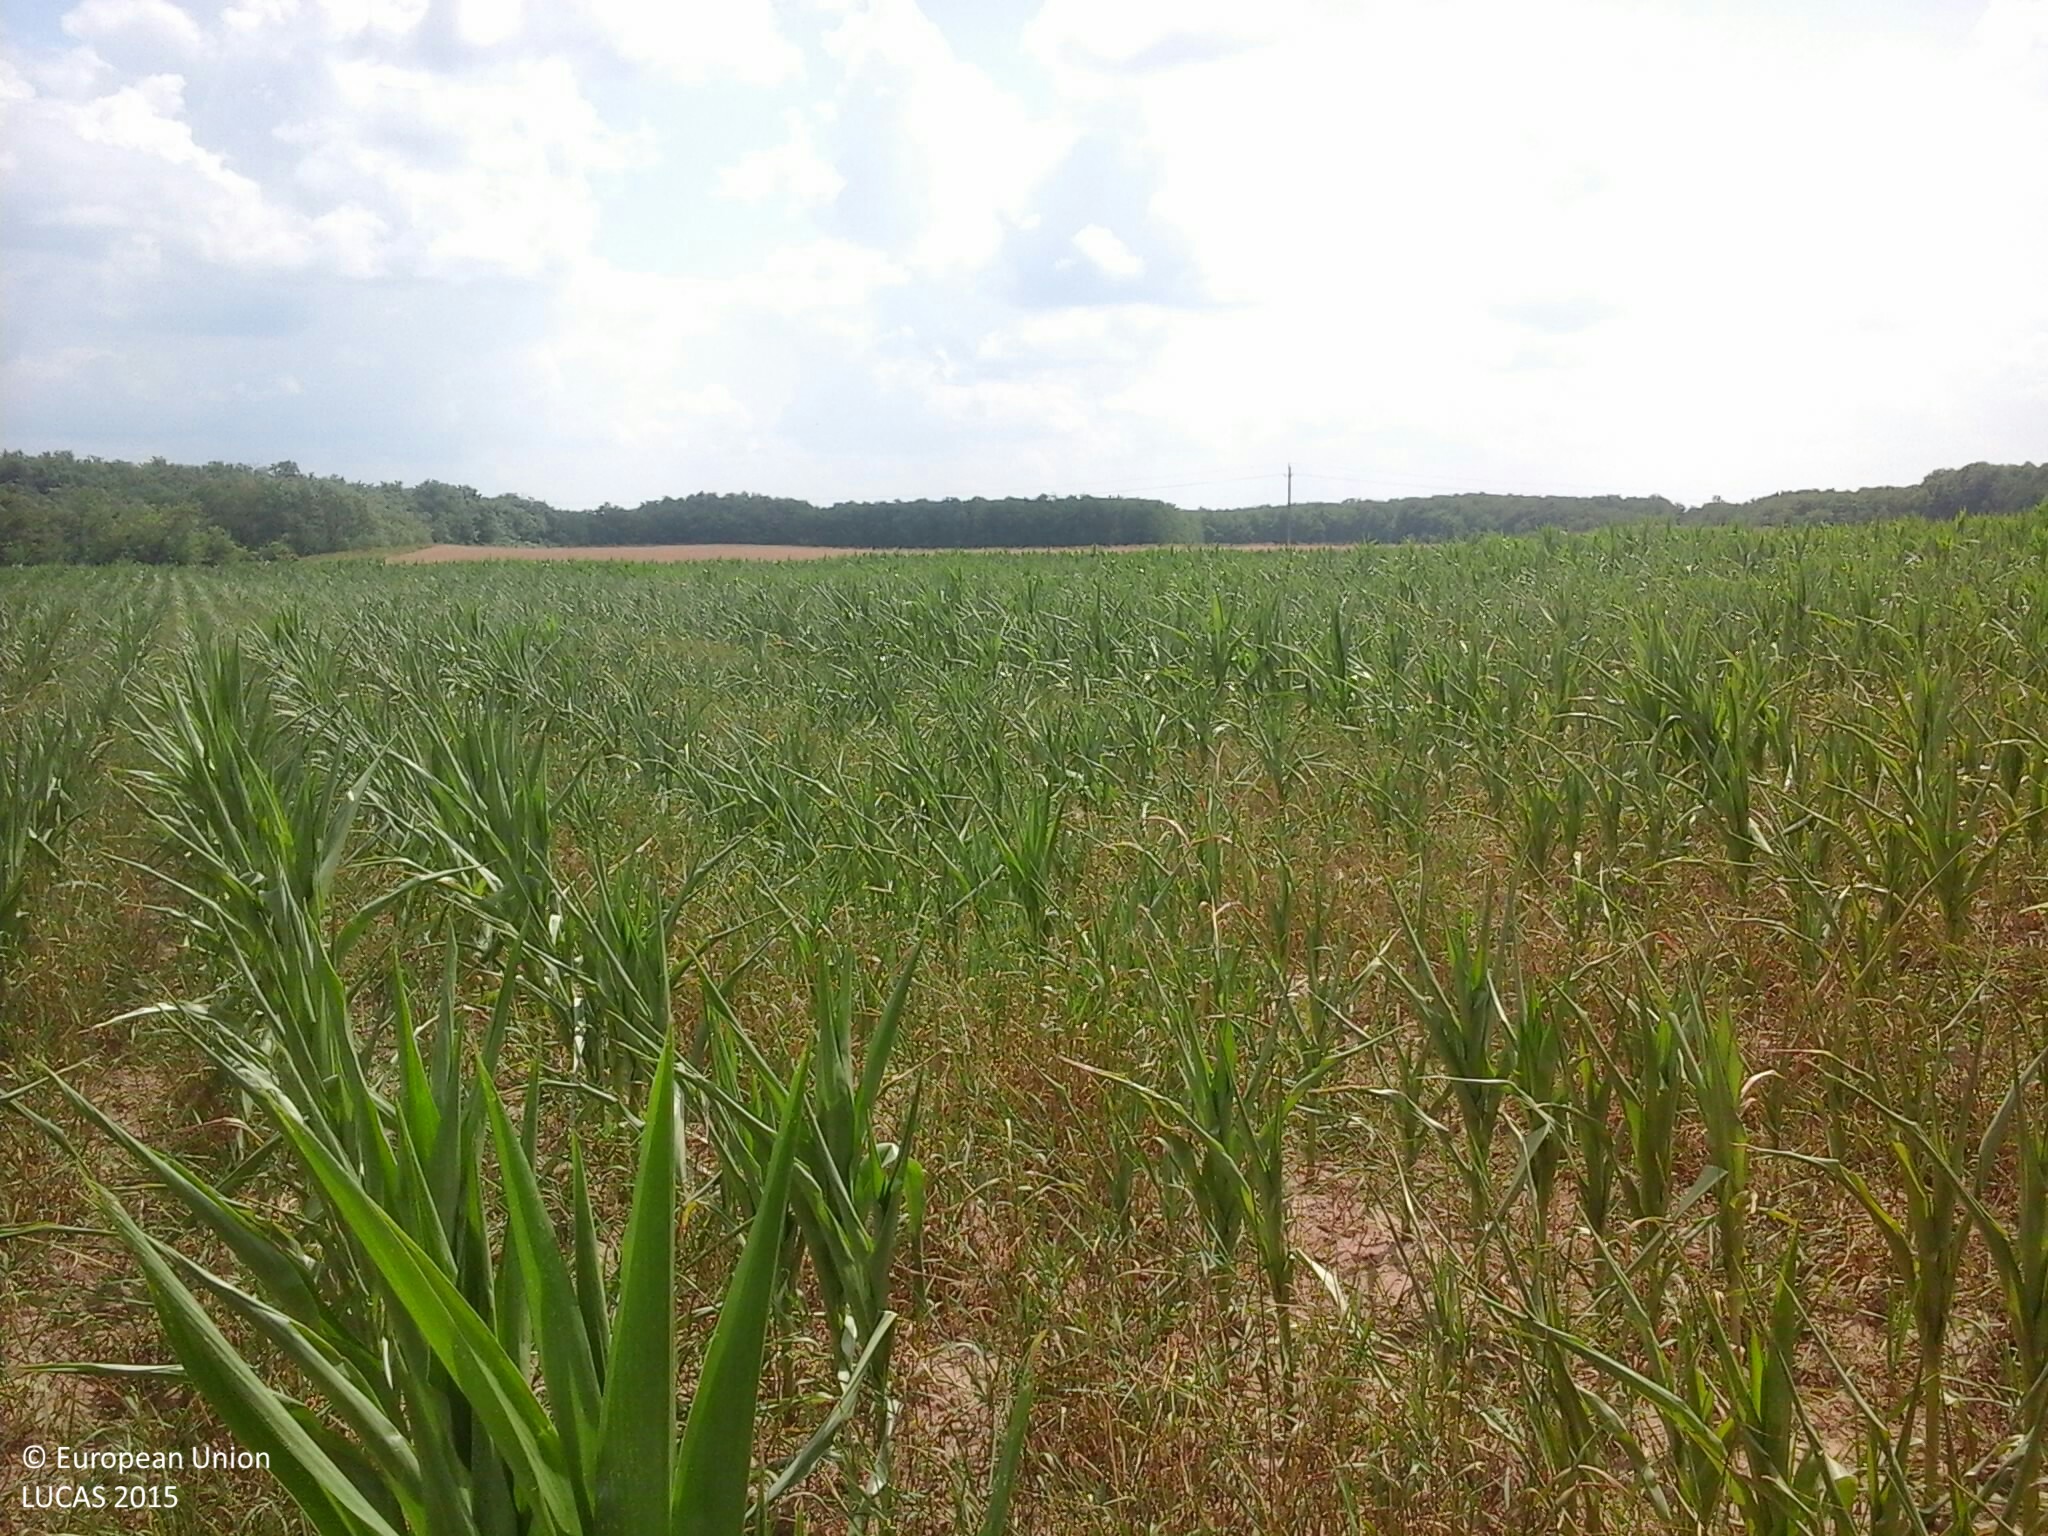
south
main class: Cropland
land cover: Maize
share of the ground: 25 - 50 %
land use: Agriculture (excluding fallow land and kitchen gardens)
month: July
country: HU
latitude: 47.8225
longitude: 22.1413
